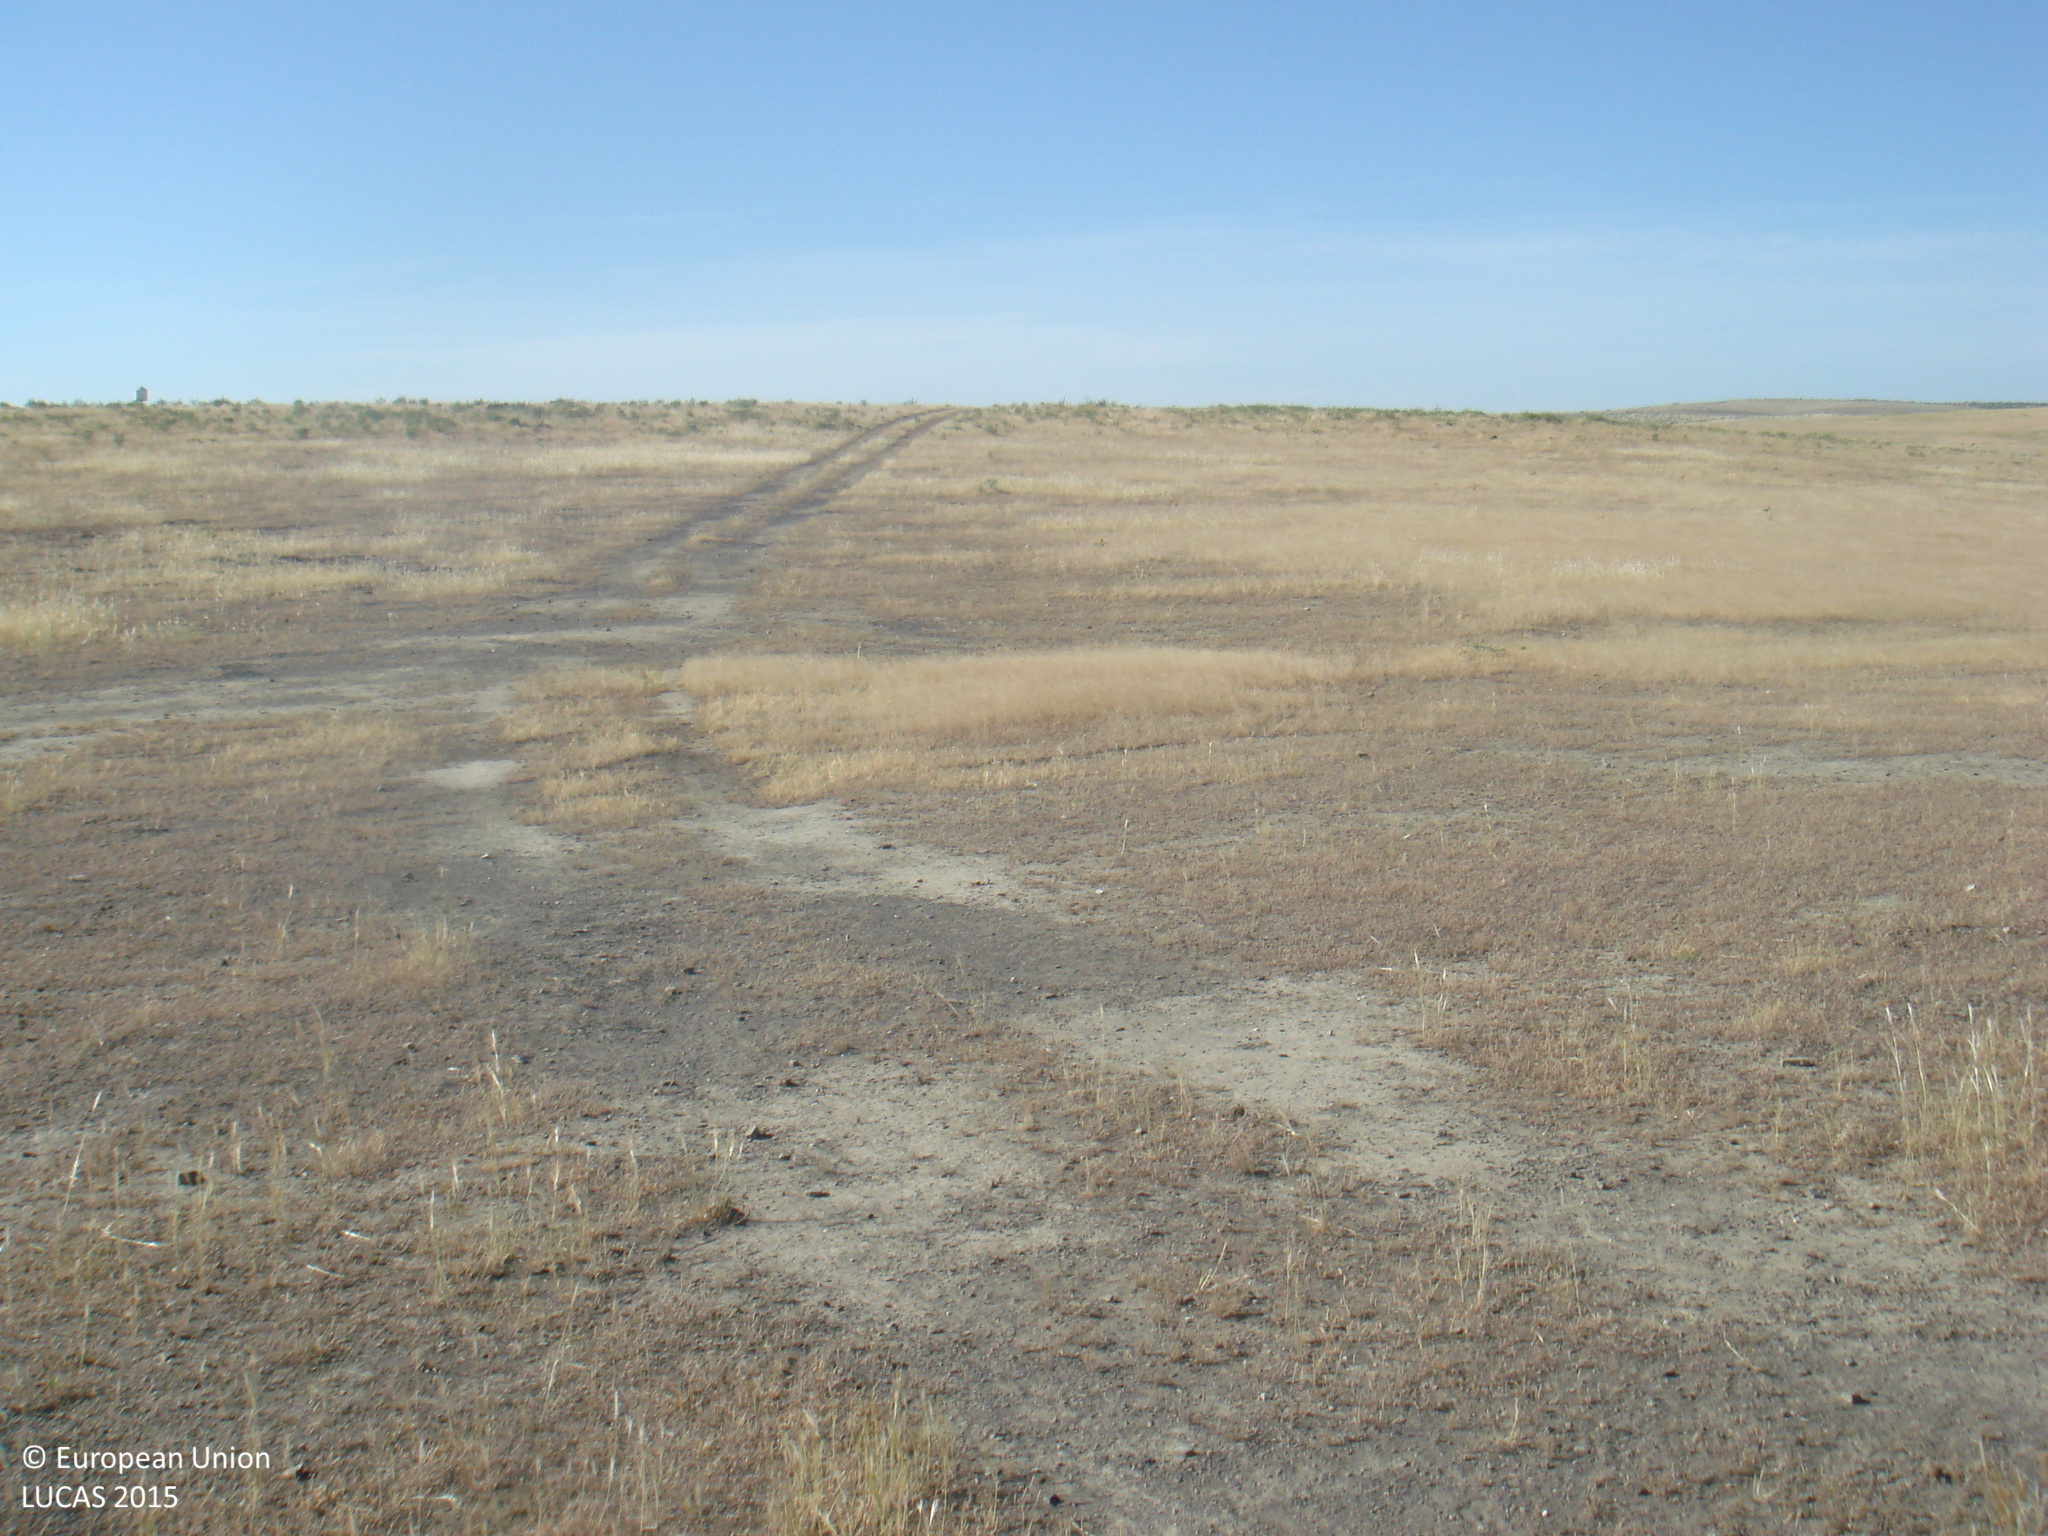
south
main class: Grassland
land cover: Spontaneously vegetated surfaces
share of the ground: > 75 %
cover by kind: herbaceous plants 100 %
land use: Agriculture (excluding fallow land and kitchen gardens)
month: May
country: ES
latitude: 38.5975
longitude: -5.0832
